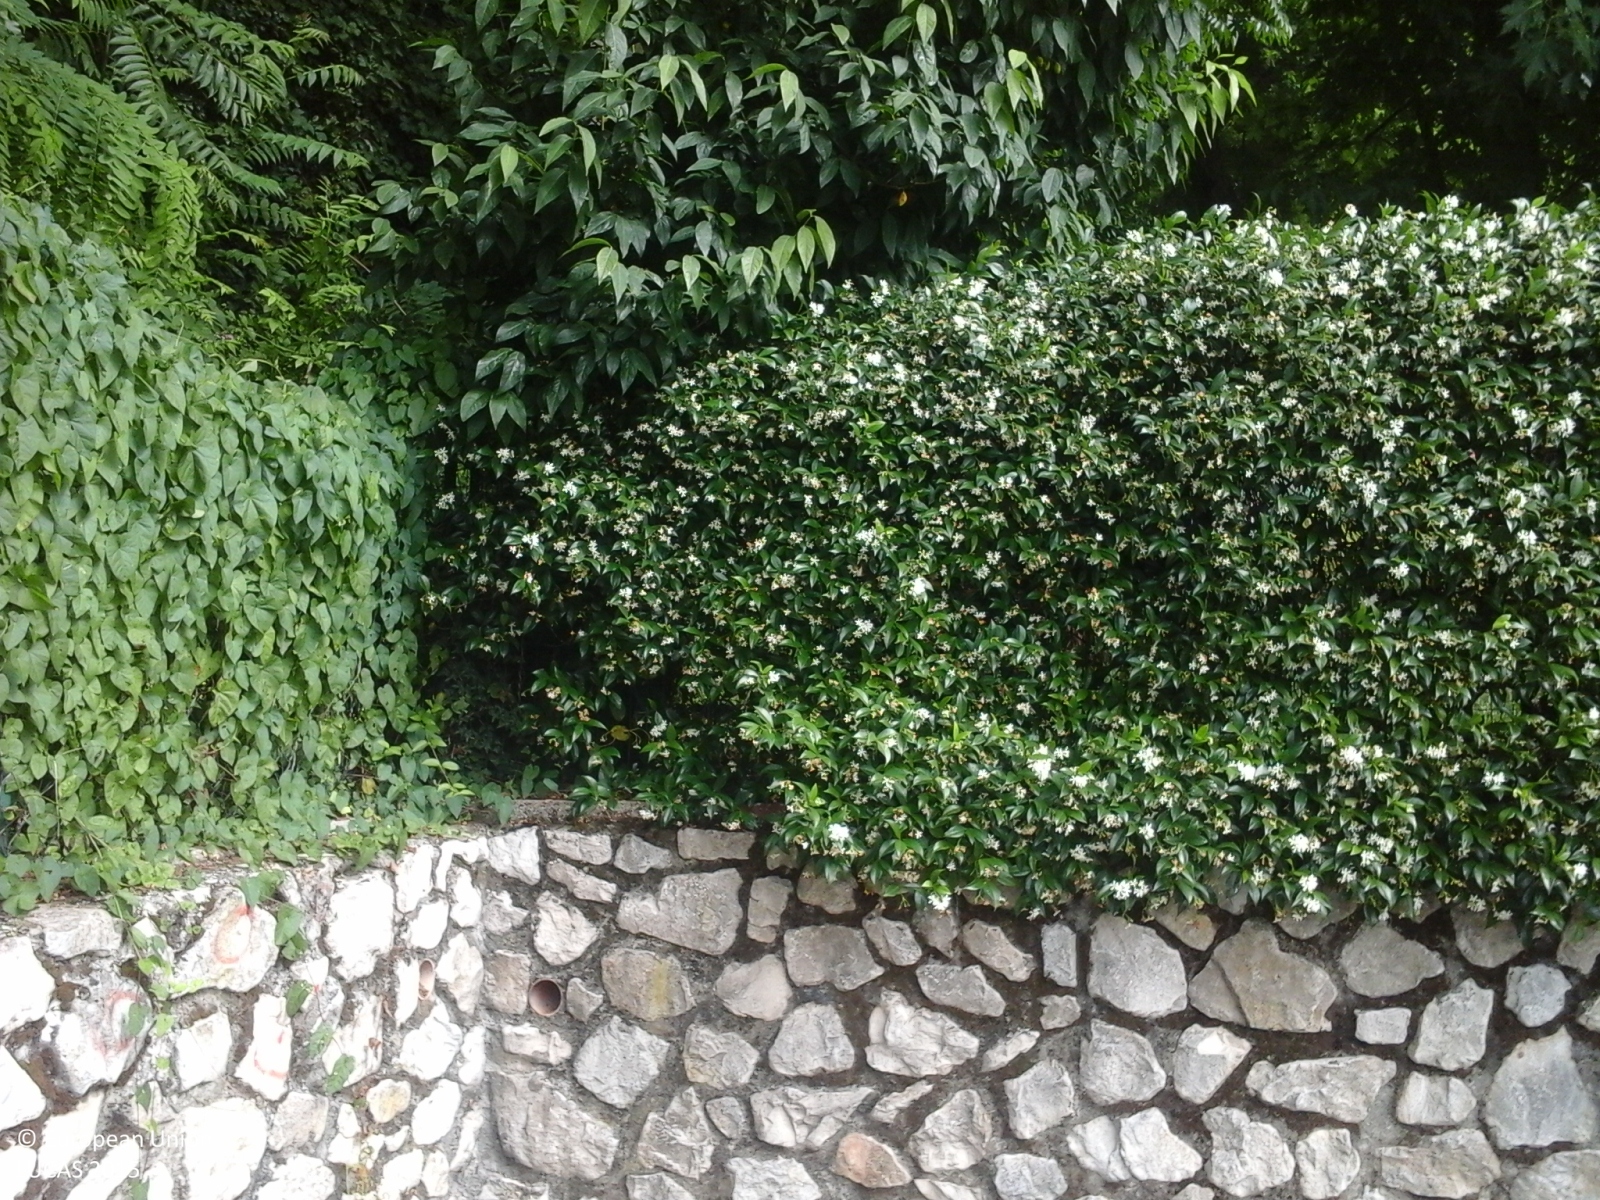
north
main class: Woodland
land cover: Broadleaved woodland
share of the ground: > 75 %
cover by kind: broadleaved forest trees 100 %
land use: Residential
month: June
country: IT
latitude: 45.7097
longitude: 11.5262
